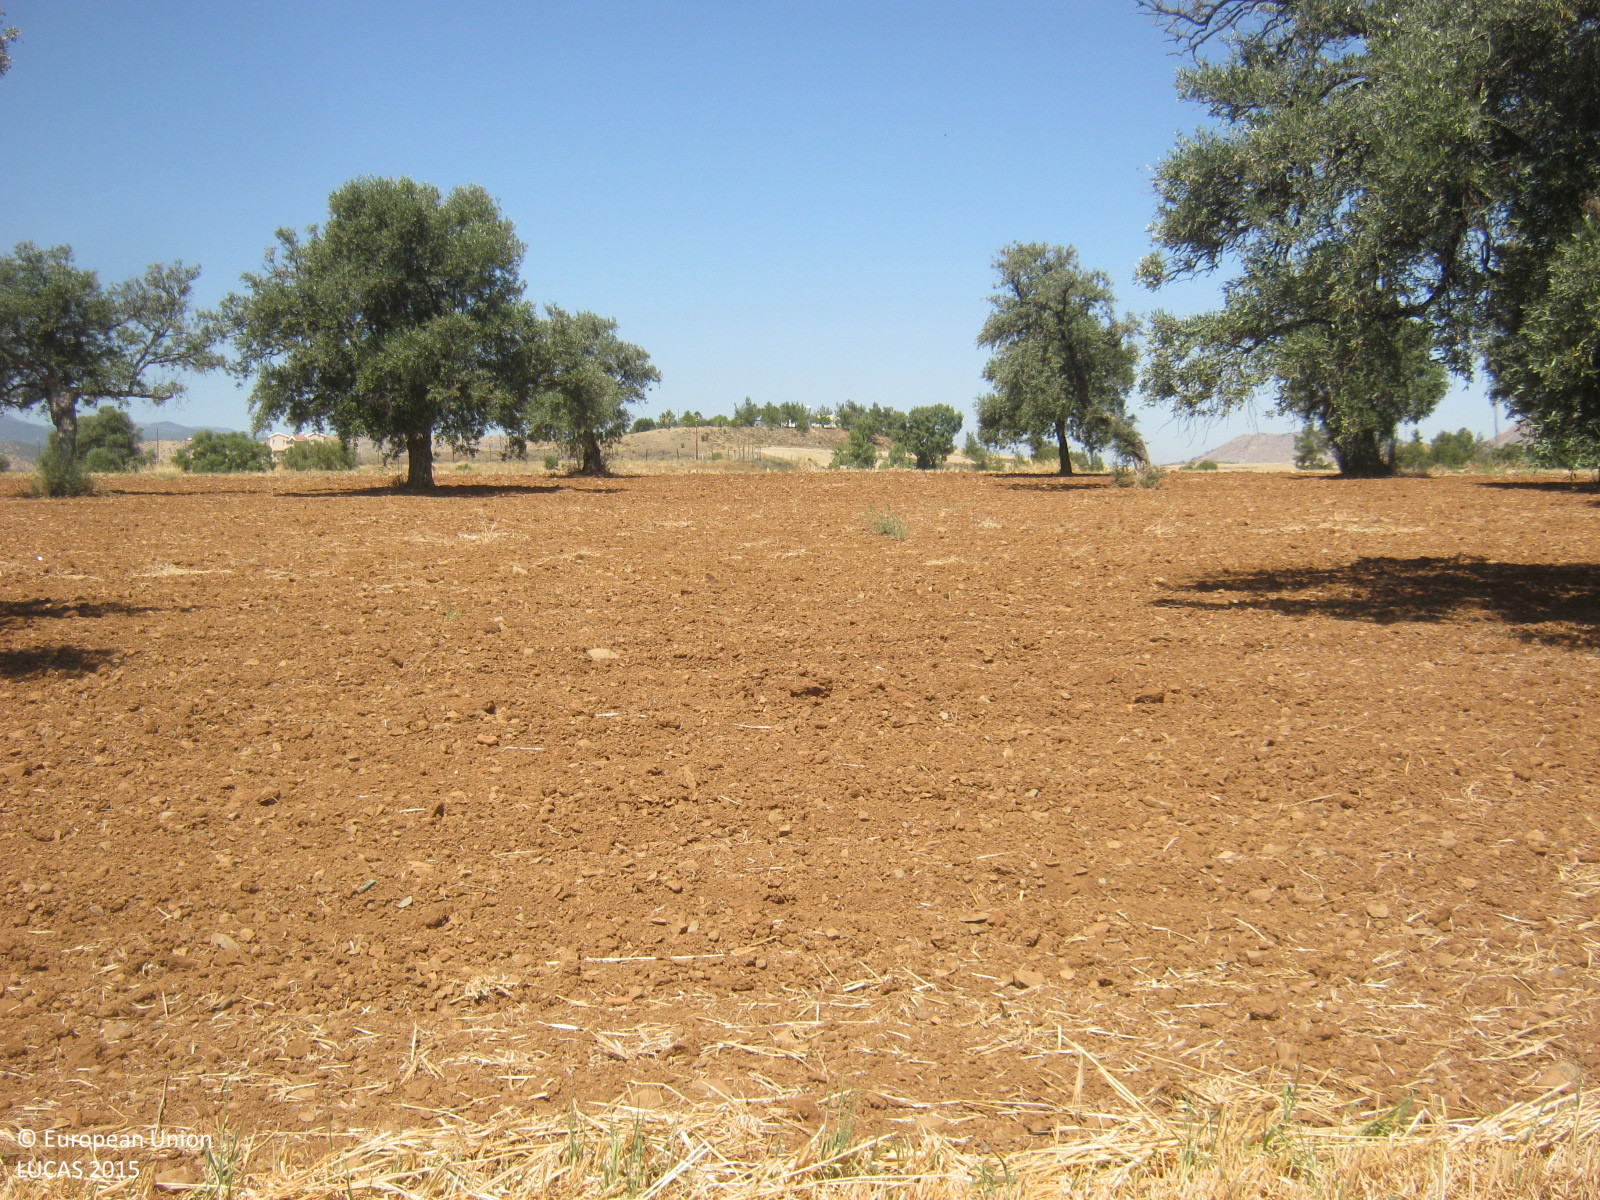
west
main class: Cropland
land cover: Barley
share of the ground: < 10 %
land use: Agriculture (excluding fallow land and kitchen gardens)
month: June
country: CY
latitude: 35.0271
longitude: 33.1880
